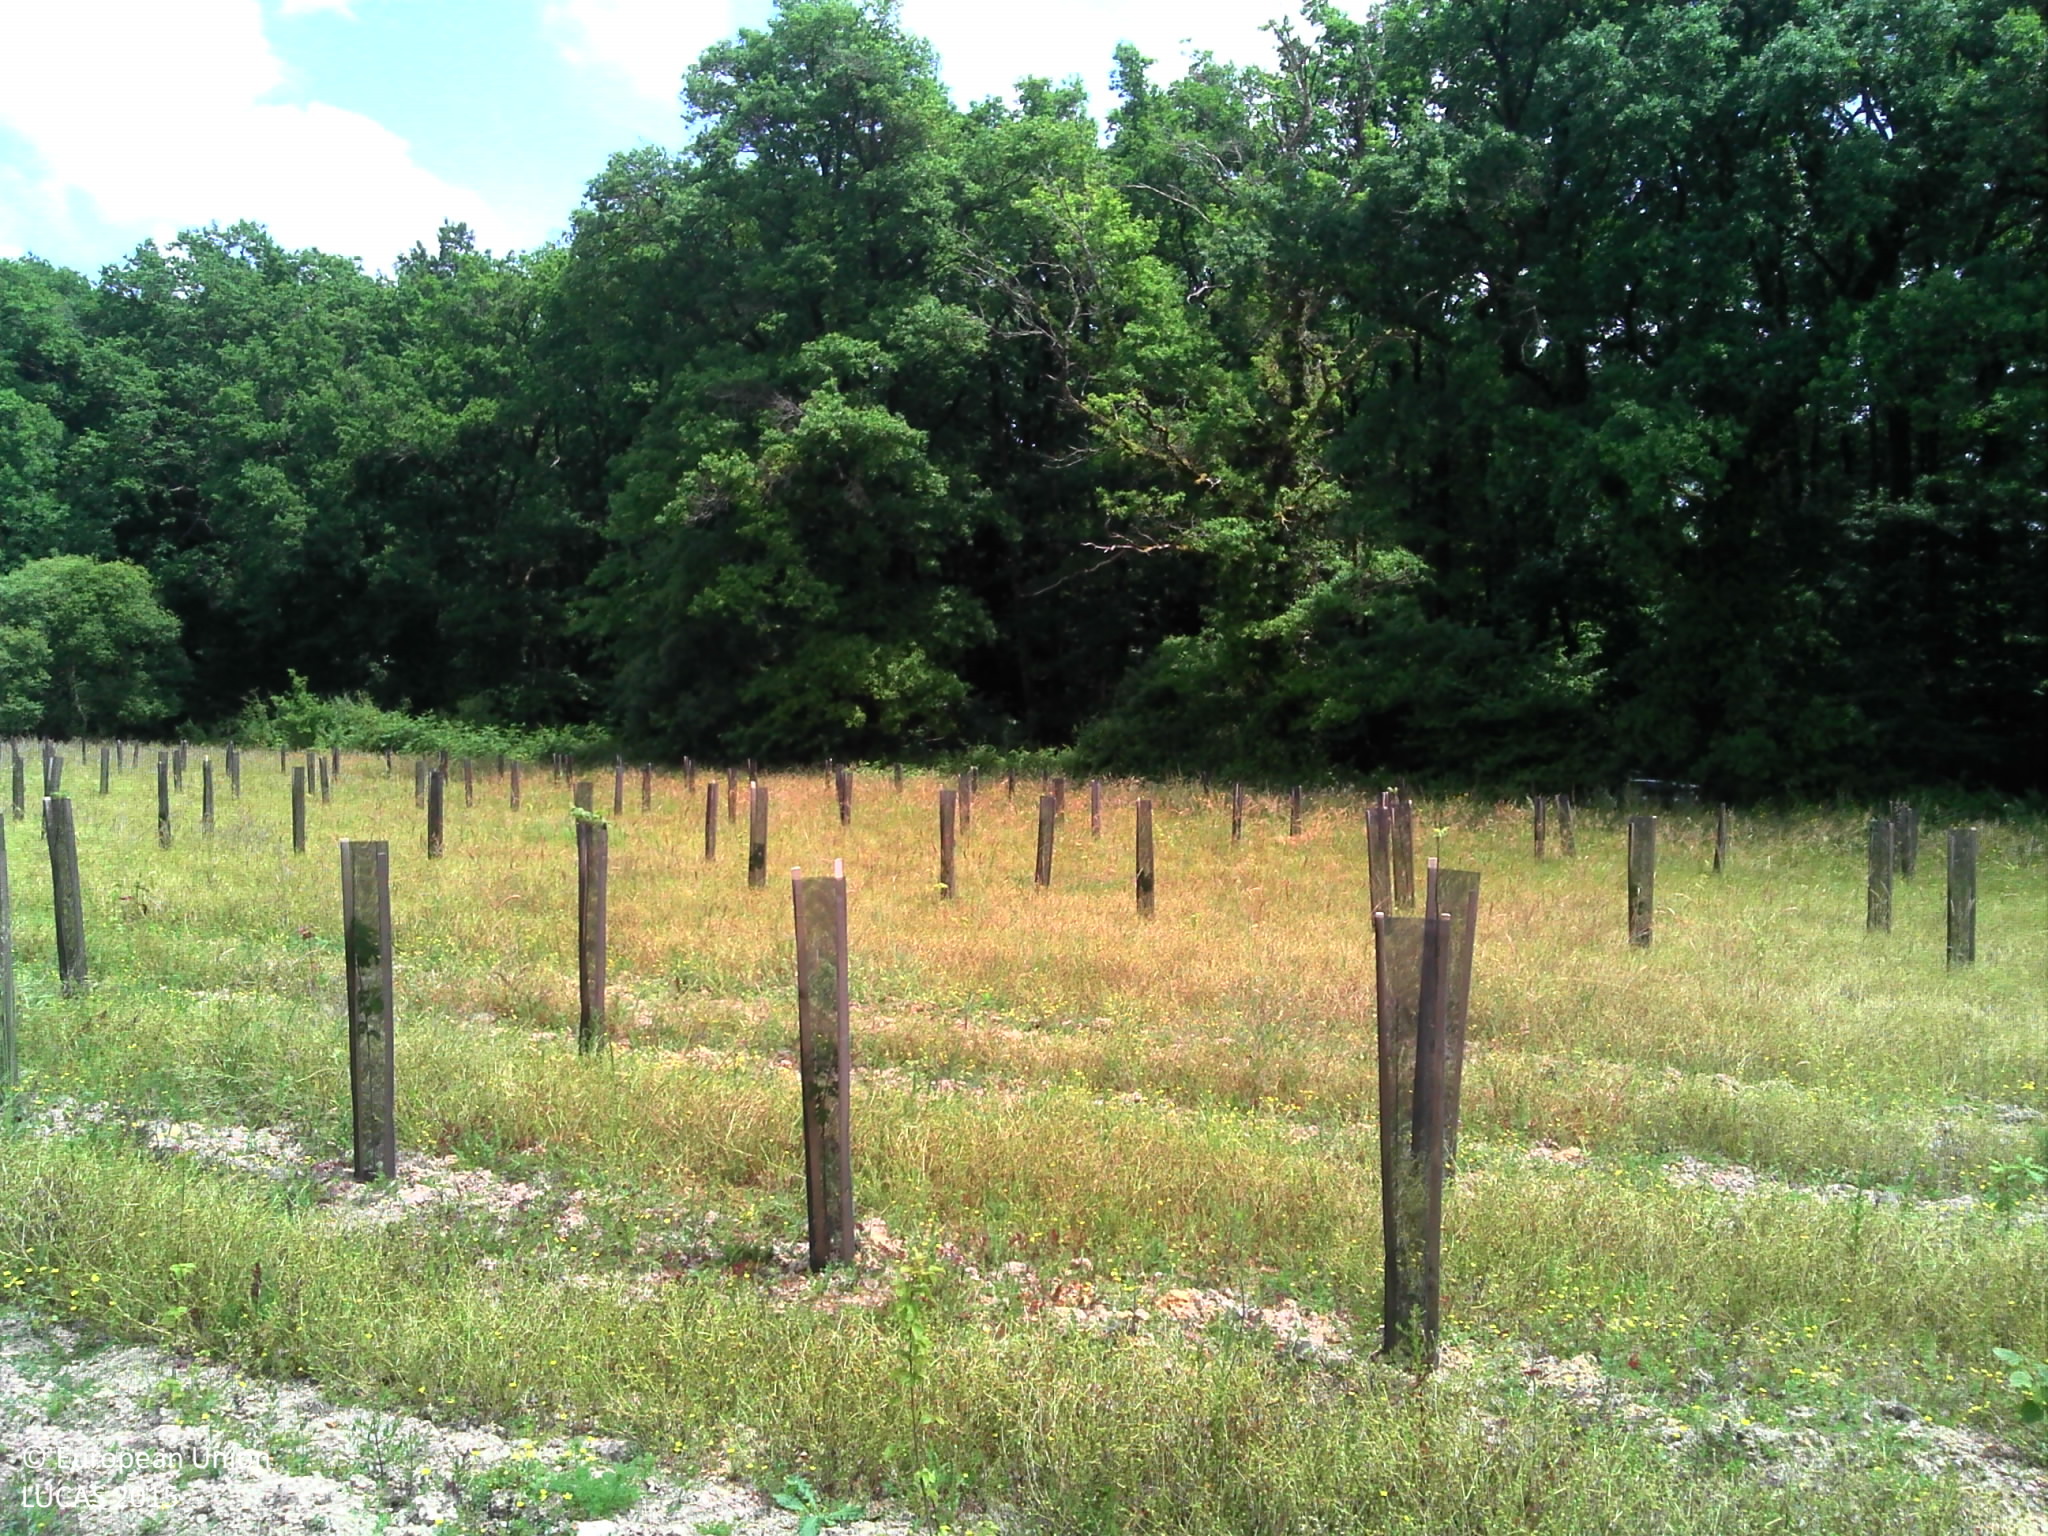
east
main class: Cropland
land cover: Nurseries
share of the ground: 10 - 25 %
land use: Forestry
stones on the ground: 10 - 25 %
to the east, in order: Nurseries; Managed hedges; Fences; Tracks; Broadleaved woodland
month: June
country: FR
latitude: 45.9885
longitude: 0.5741
